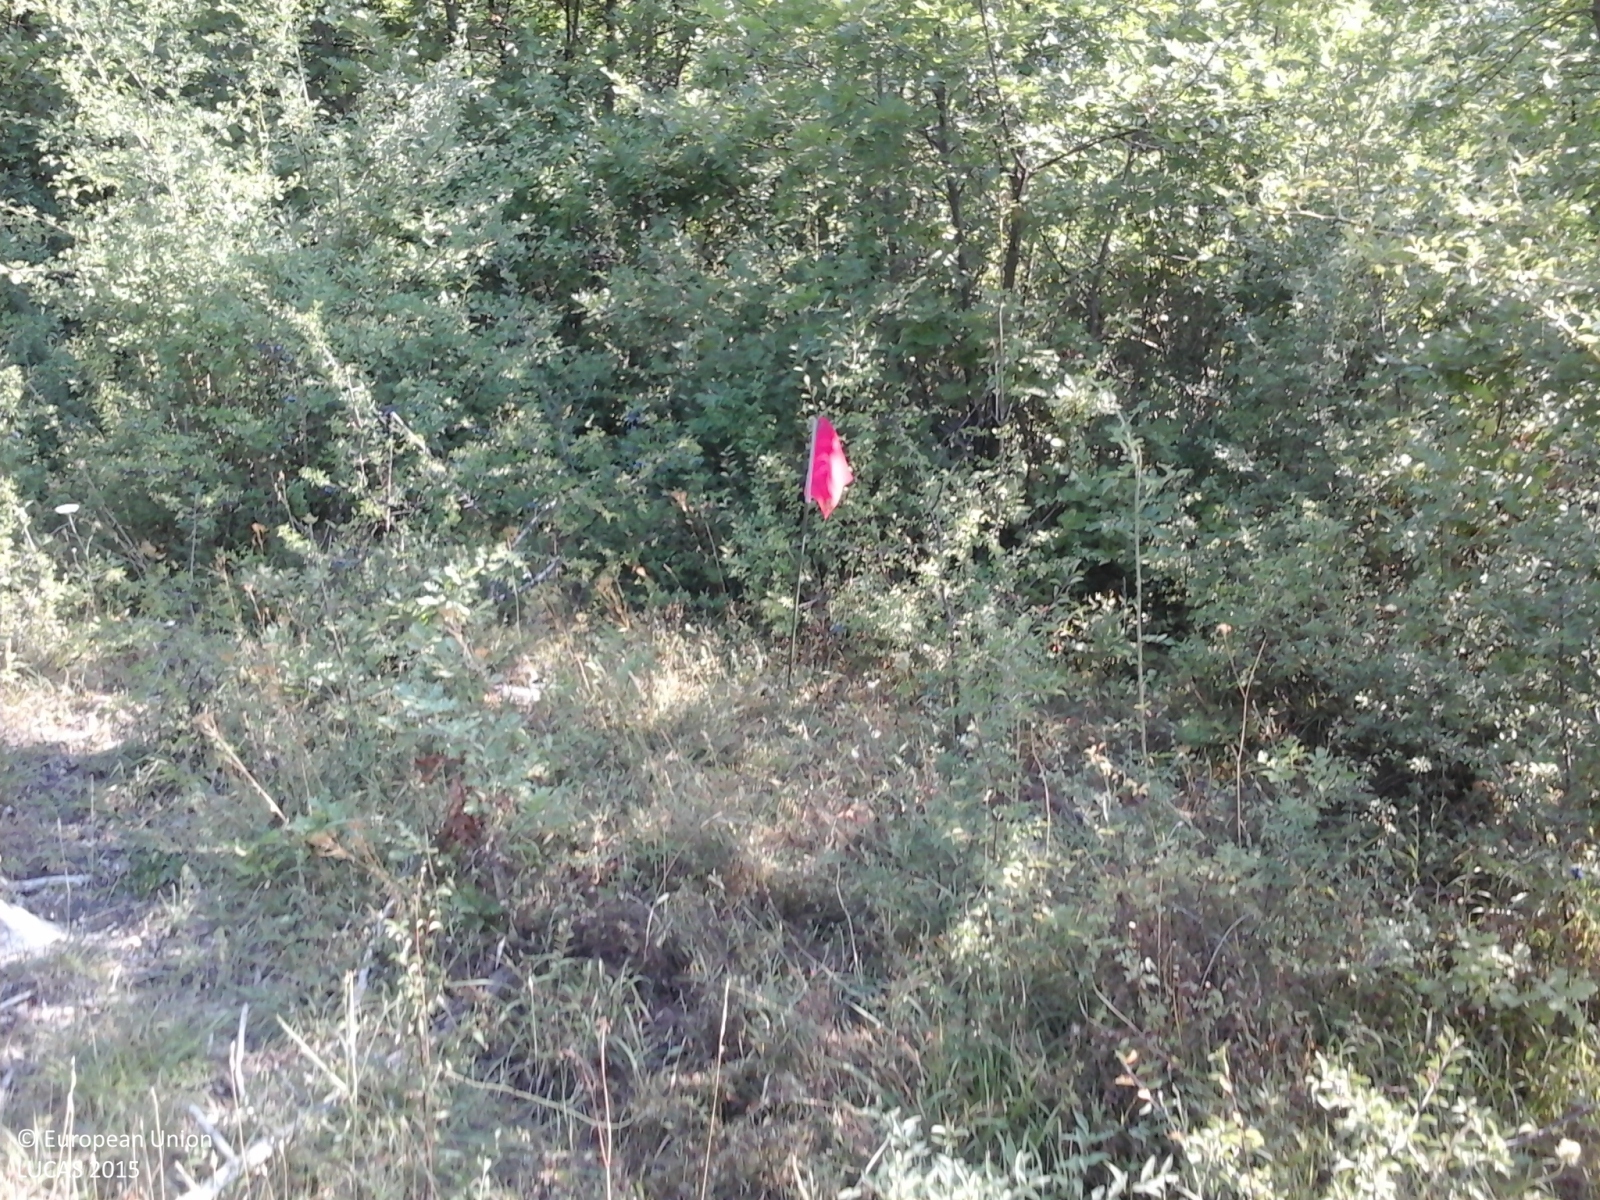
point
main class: Woodland
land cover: Broadleaved woodland
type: thermophilous deciduous forest
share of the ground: > 75 %
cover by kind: broadleaved forest trees 100 %
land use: Forestry
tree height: > 5 m
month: August
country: IT
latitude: 43.7297
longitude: 12.2910
